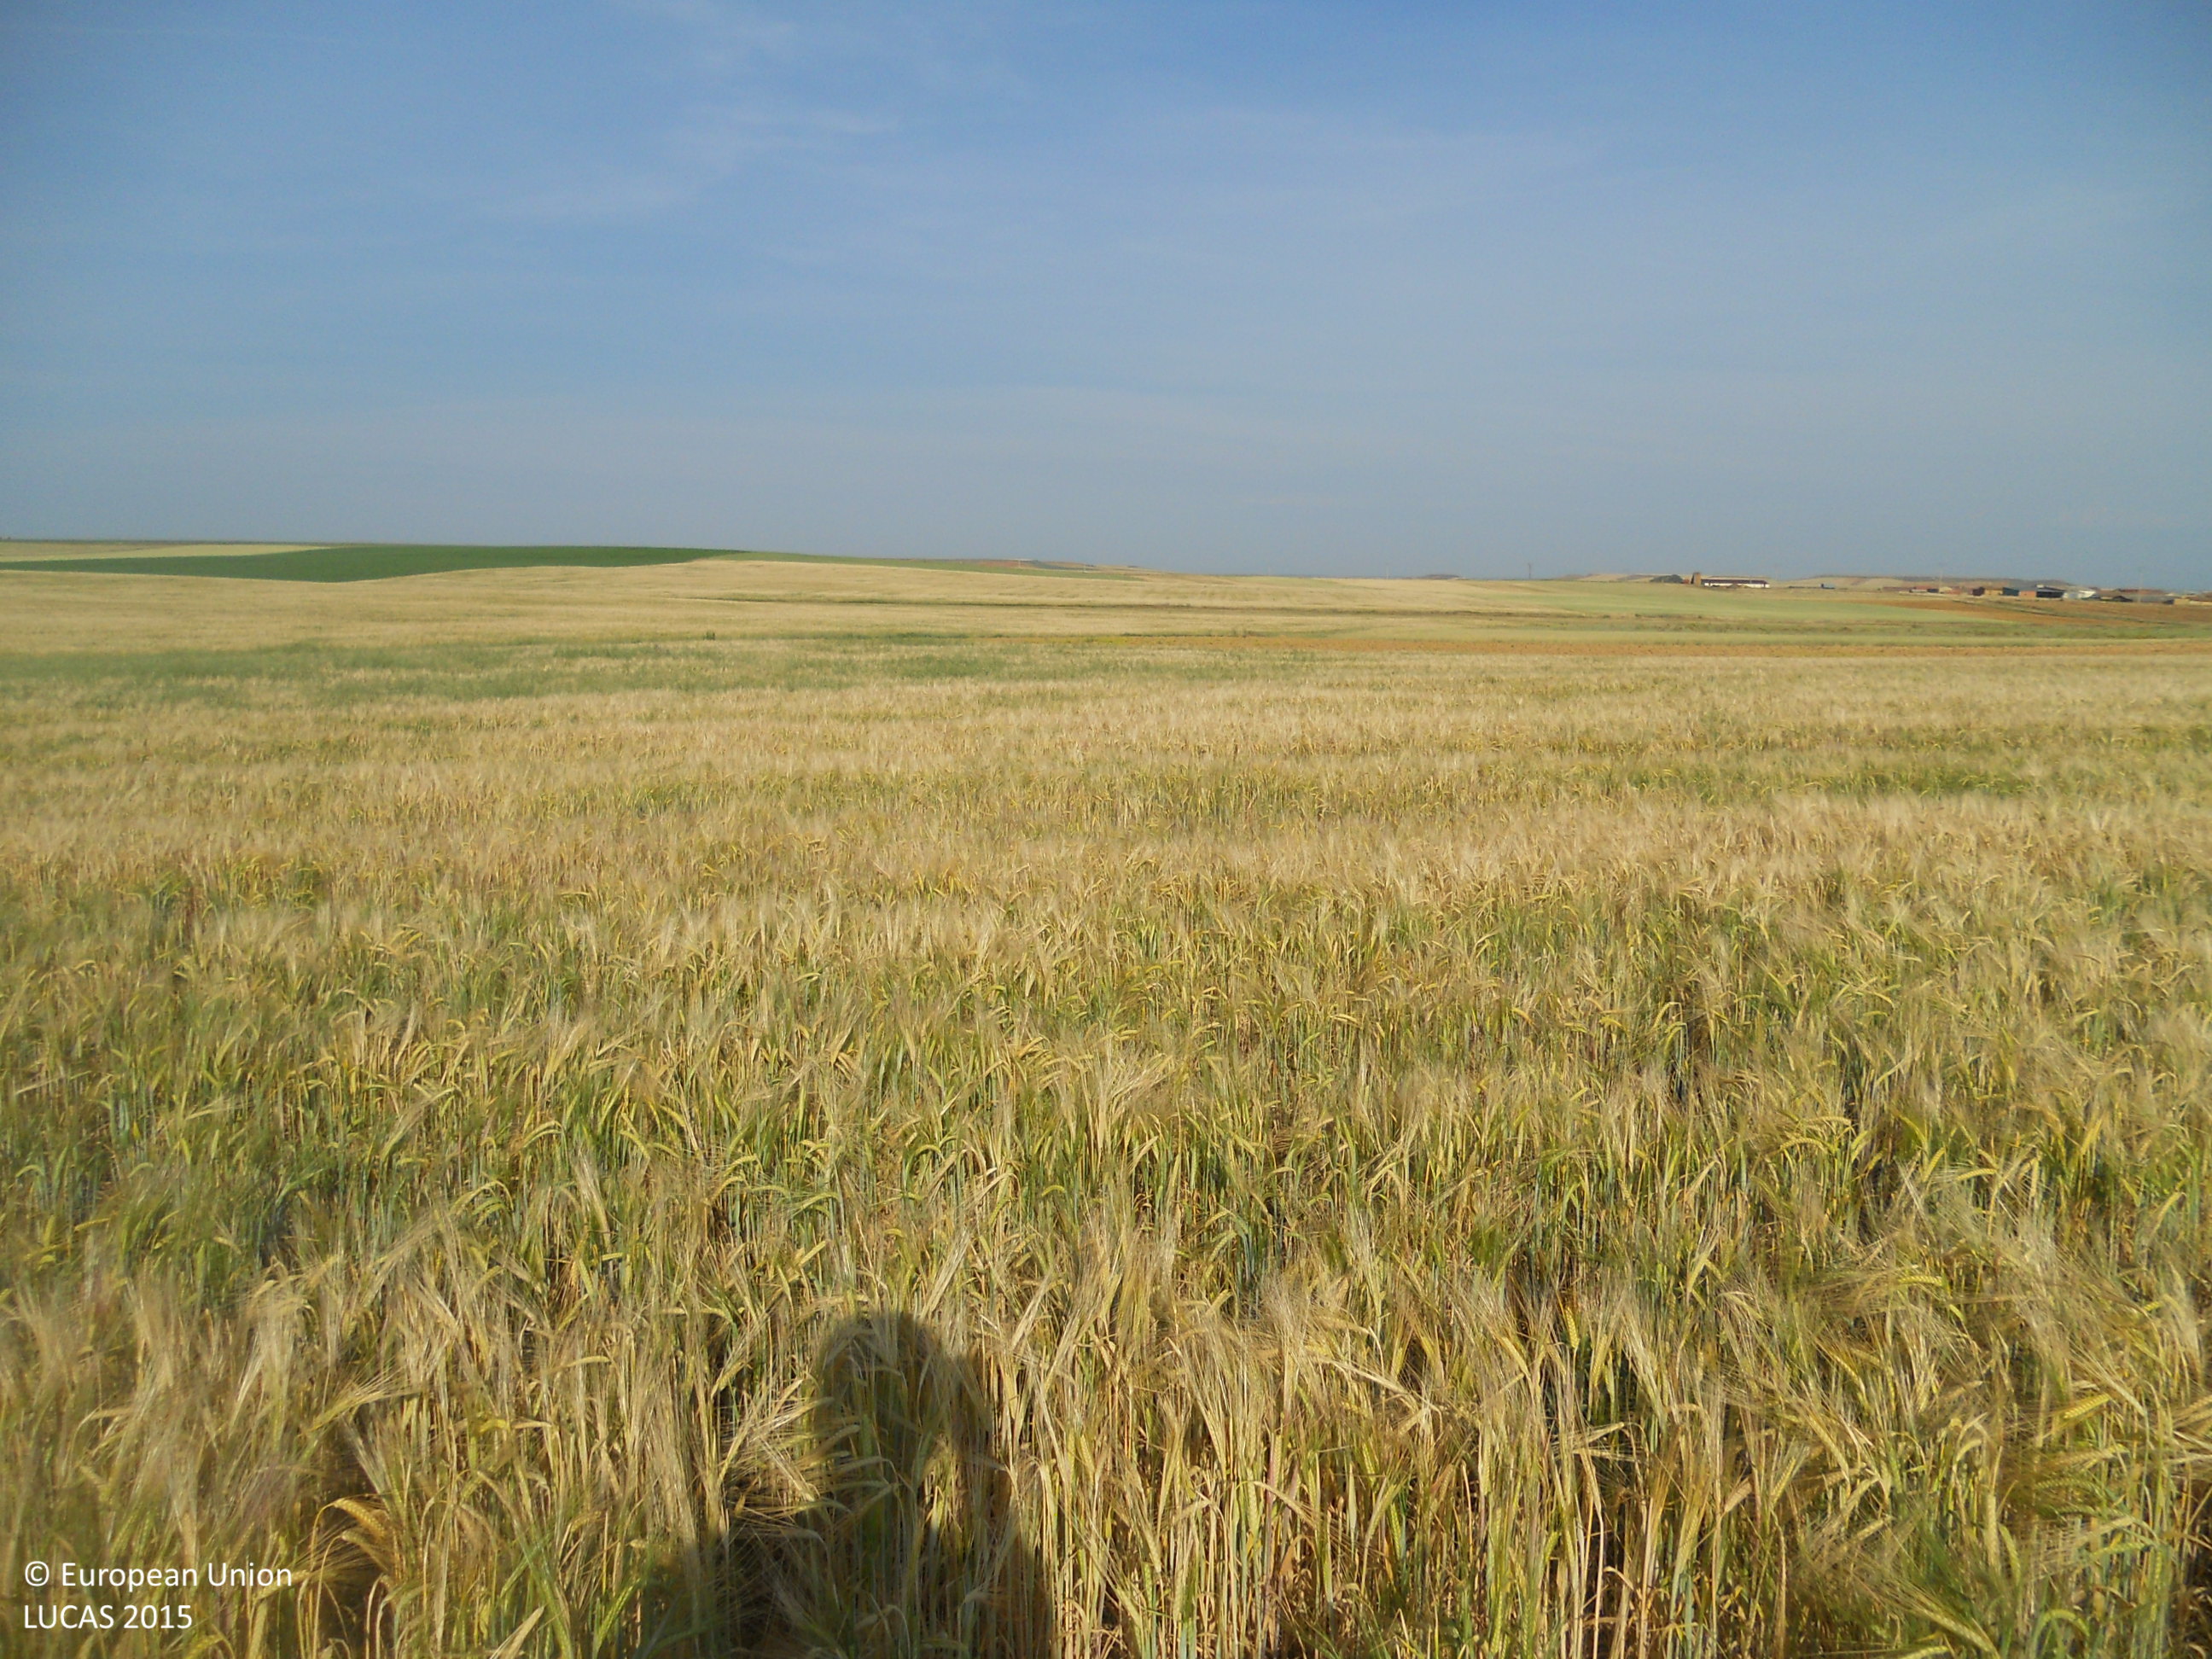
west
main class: Cropland
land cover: Barley
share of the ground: > 75 %
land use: Agriculture (excluding fallow land and kitchen gardens)
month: June
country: ES
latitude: 42.3882
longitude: -5.3837
